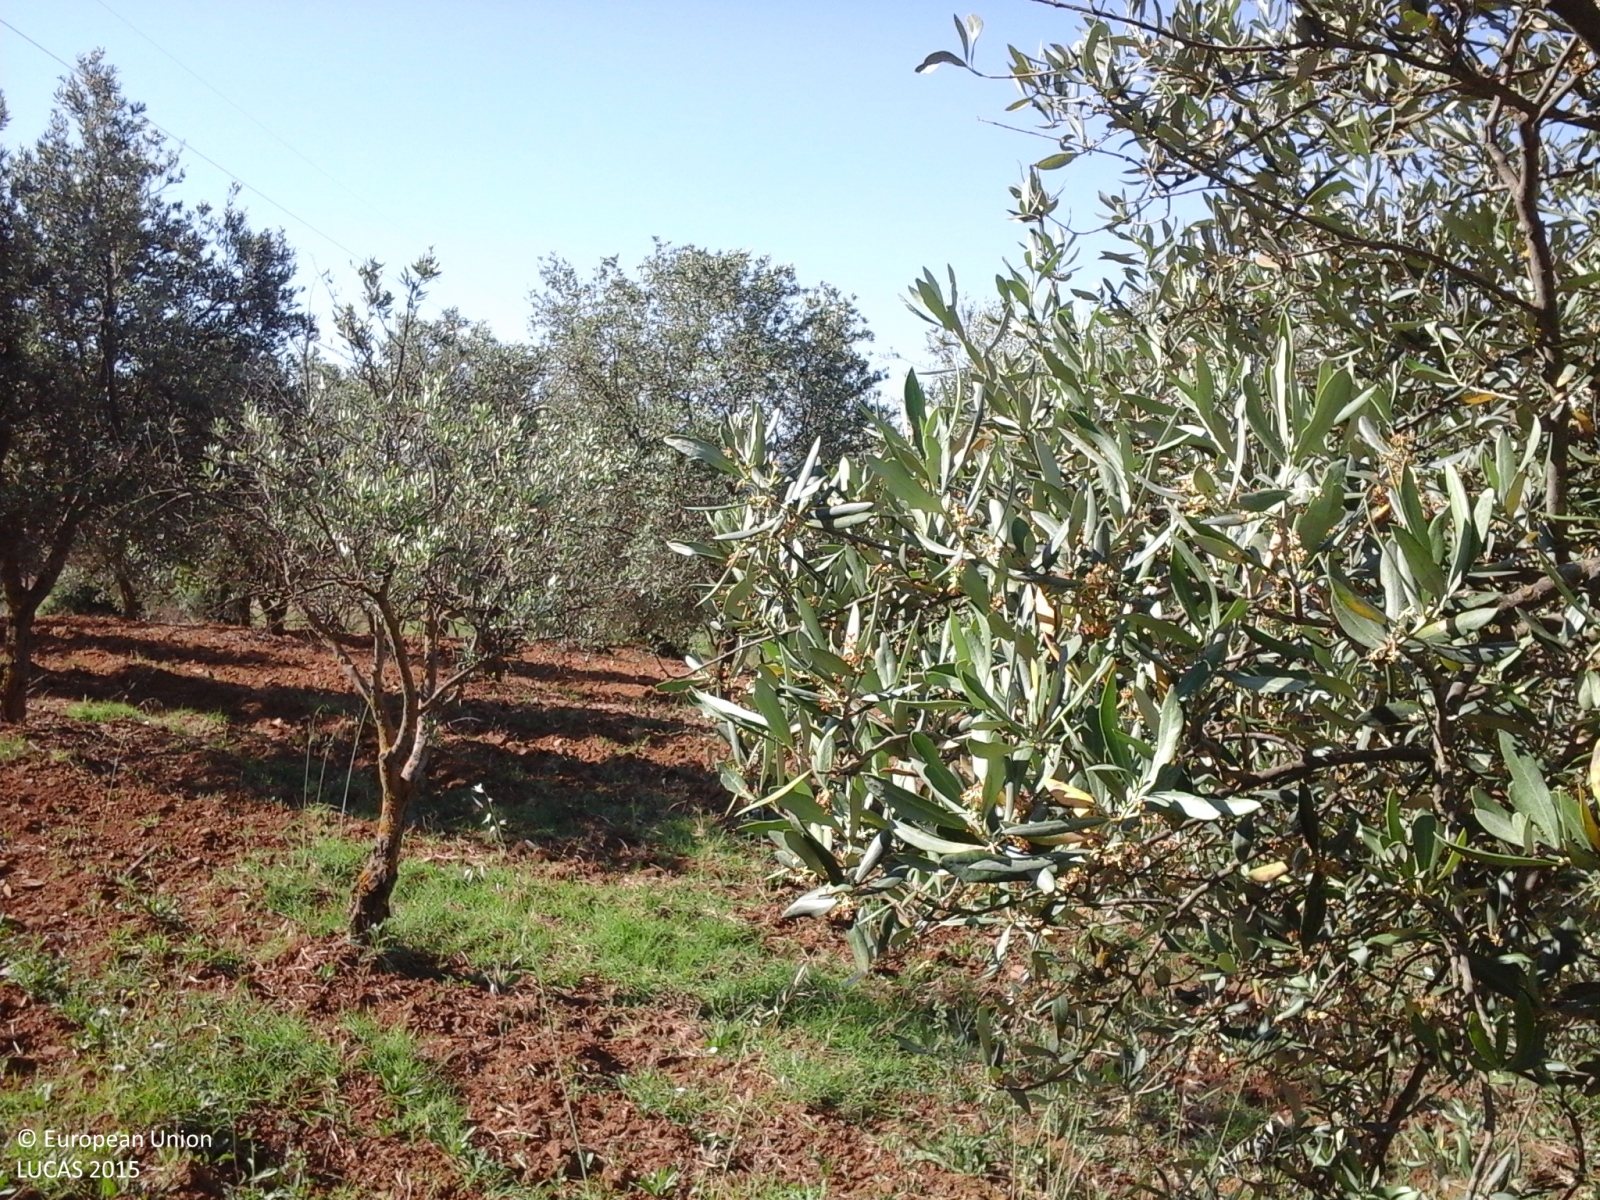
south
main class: Cropland
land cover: Olive groves
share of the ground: 50 - 75 %
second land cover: Spontaneously vegetated surfaces
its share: 10 - 25 %
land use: Agriculture (excluding fallow land and kitchen gardens)
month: June
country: IT
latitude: 37.3365
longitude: 14.4025
